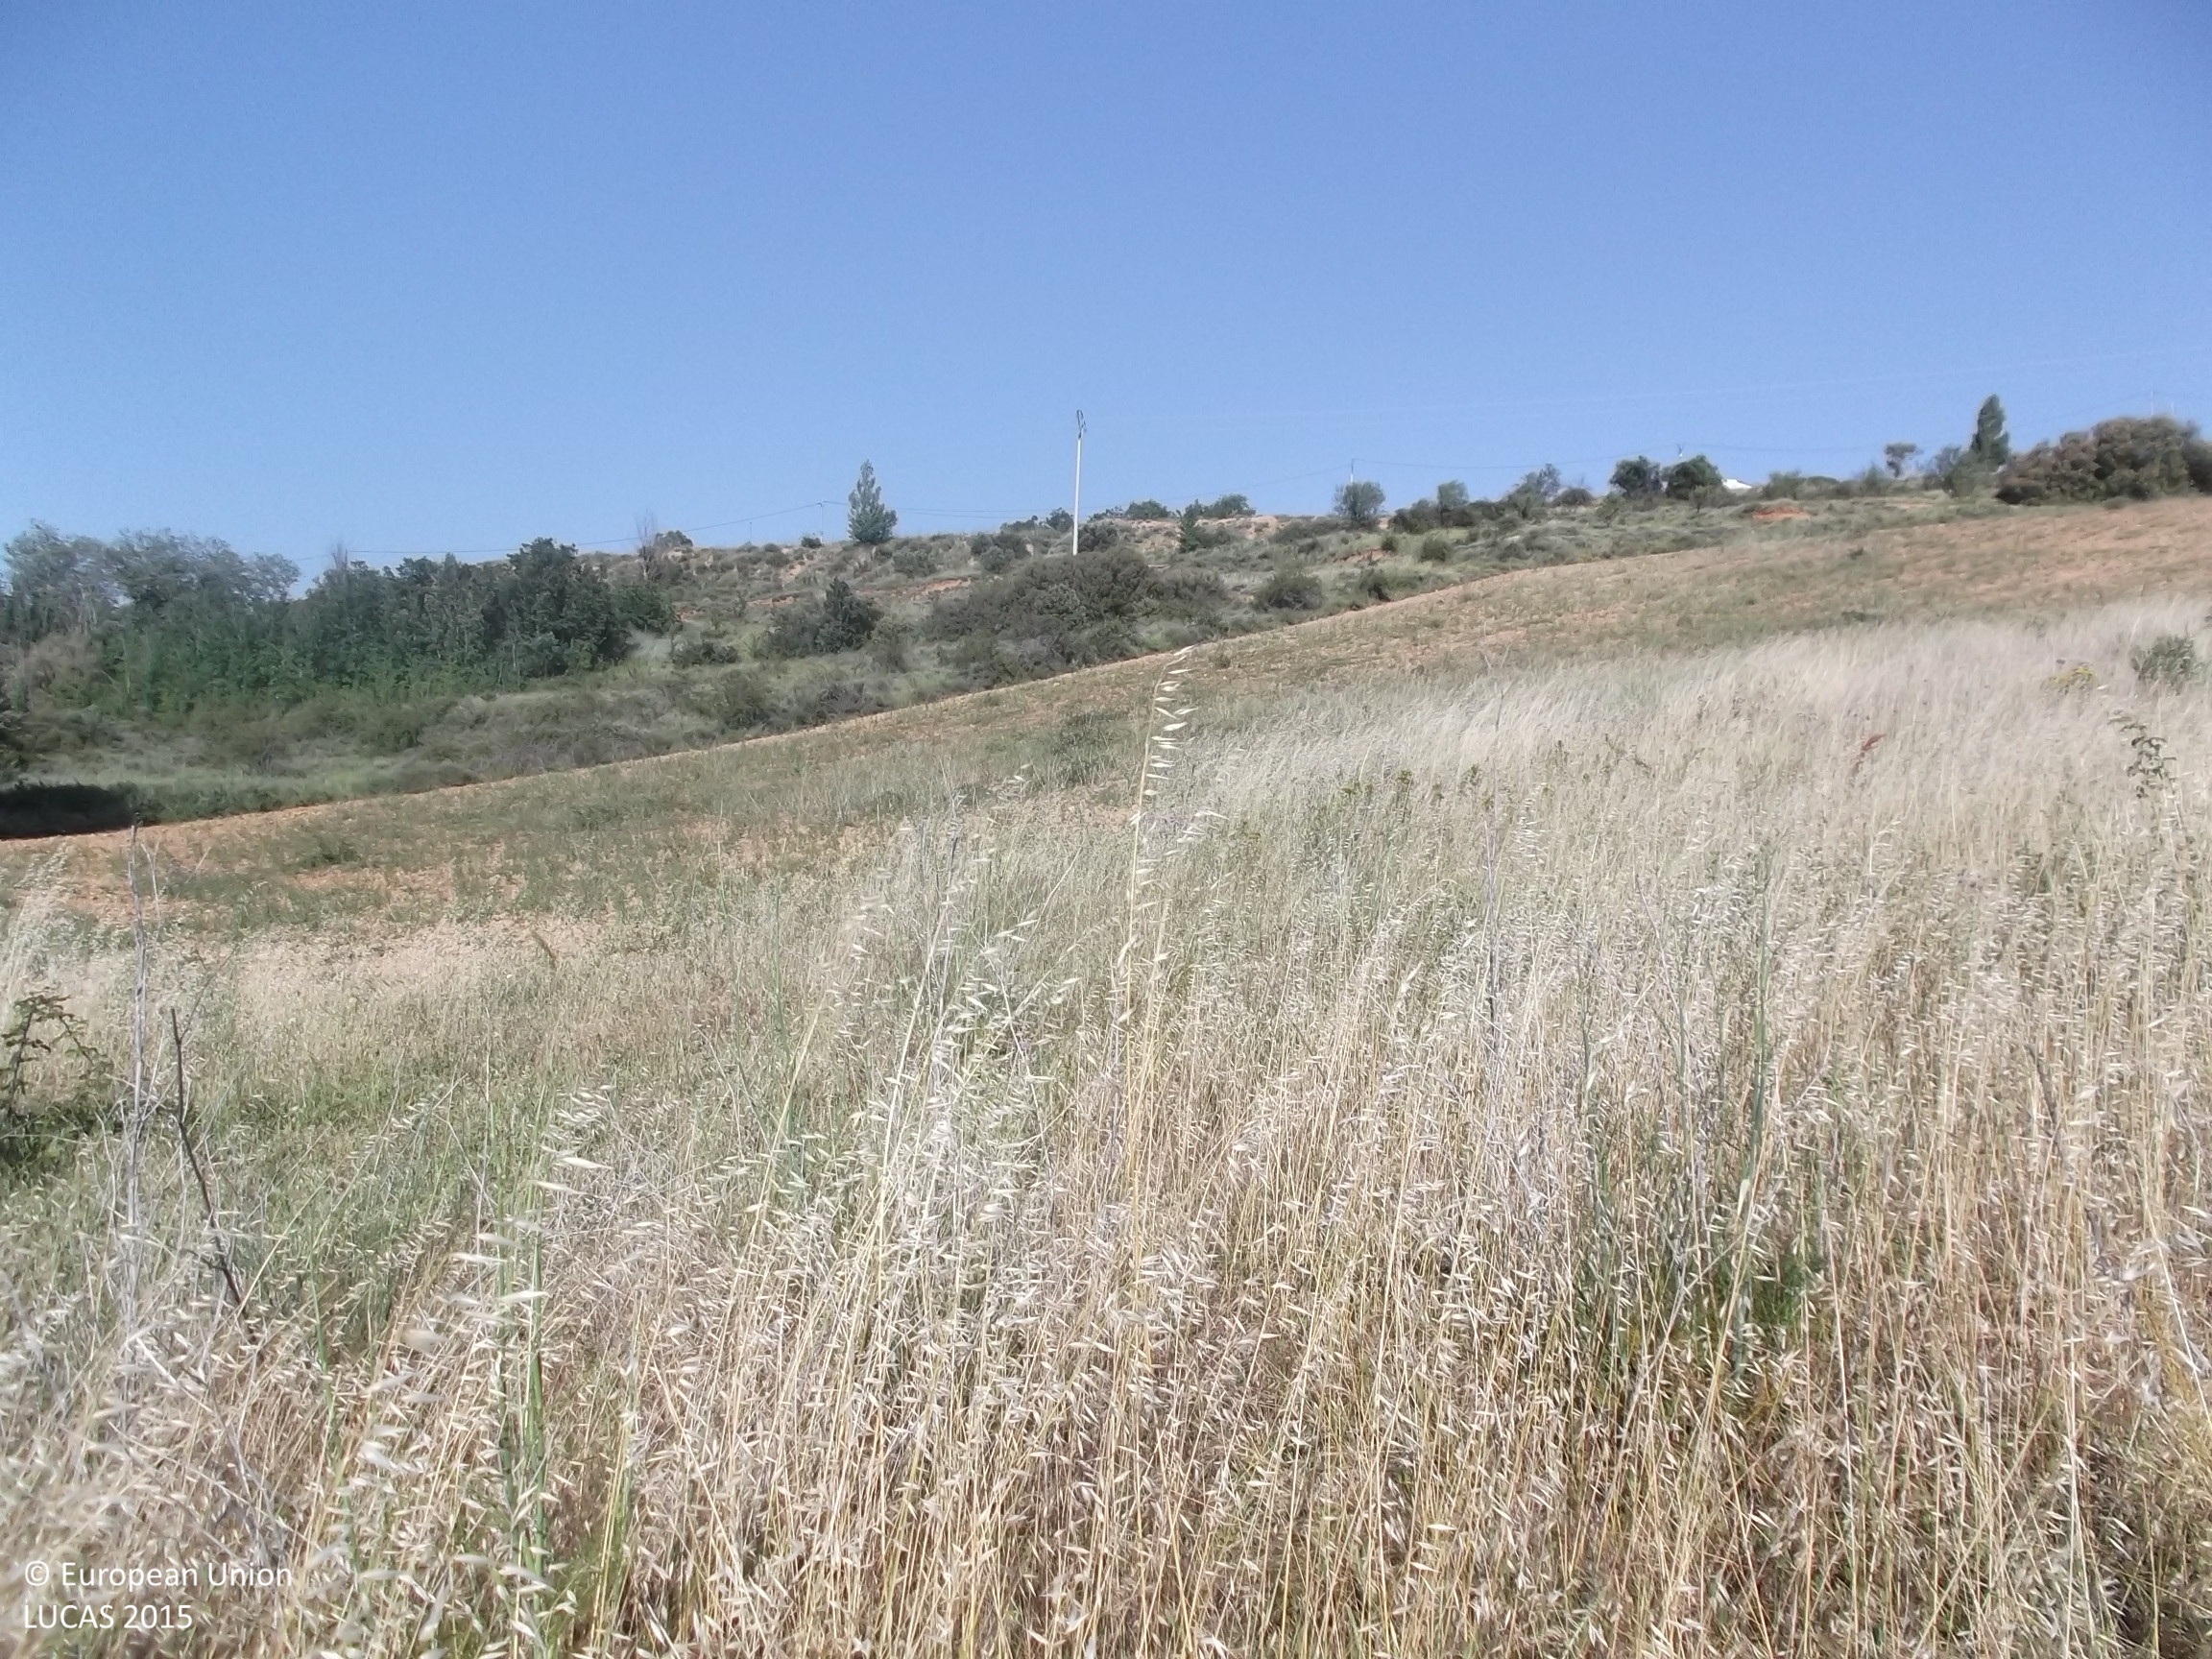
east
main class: Grassland
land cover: Spontaneously vegetated surfaces
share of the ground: > 75 %
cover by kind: herbaceous plants 90 %, unconsolidated bare surface 5 %
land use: Fallow land
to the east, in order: Spontaneously vegetated surfaces; Shrubland with sparse tree cover; Electric lines; Tracks; Shrubland with sparse tree cover; Broadleaved woodland; Paved roads, cycling and walking lanes; Electric lines; Grassland without tree/shrub cover; Artificial constructions in urban areas
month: June
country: ES
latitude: 42.3374
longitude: -2.1653
